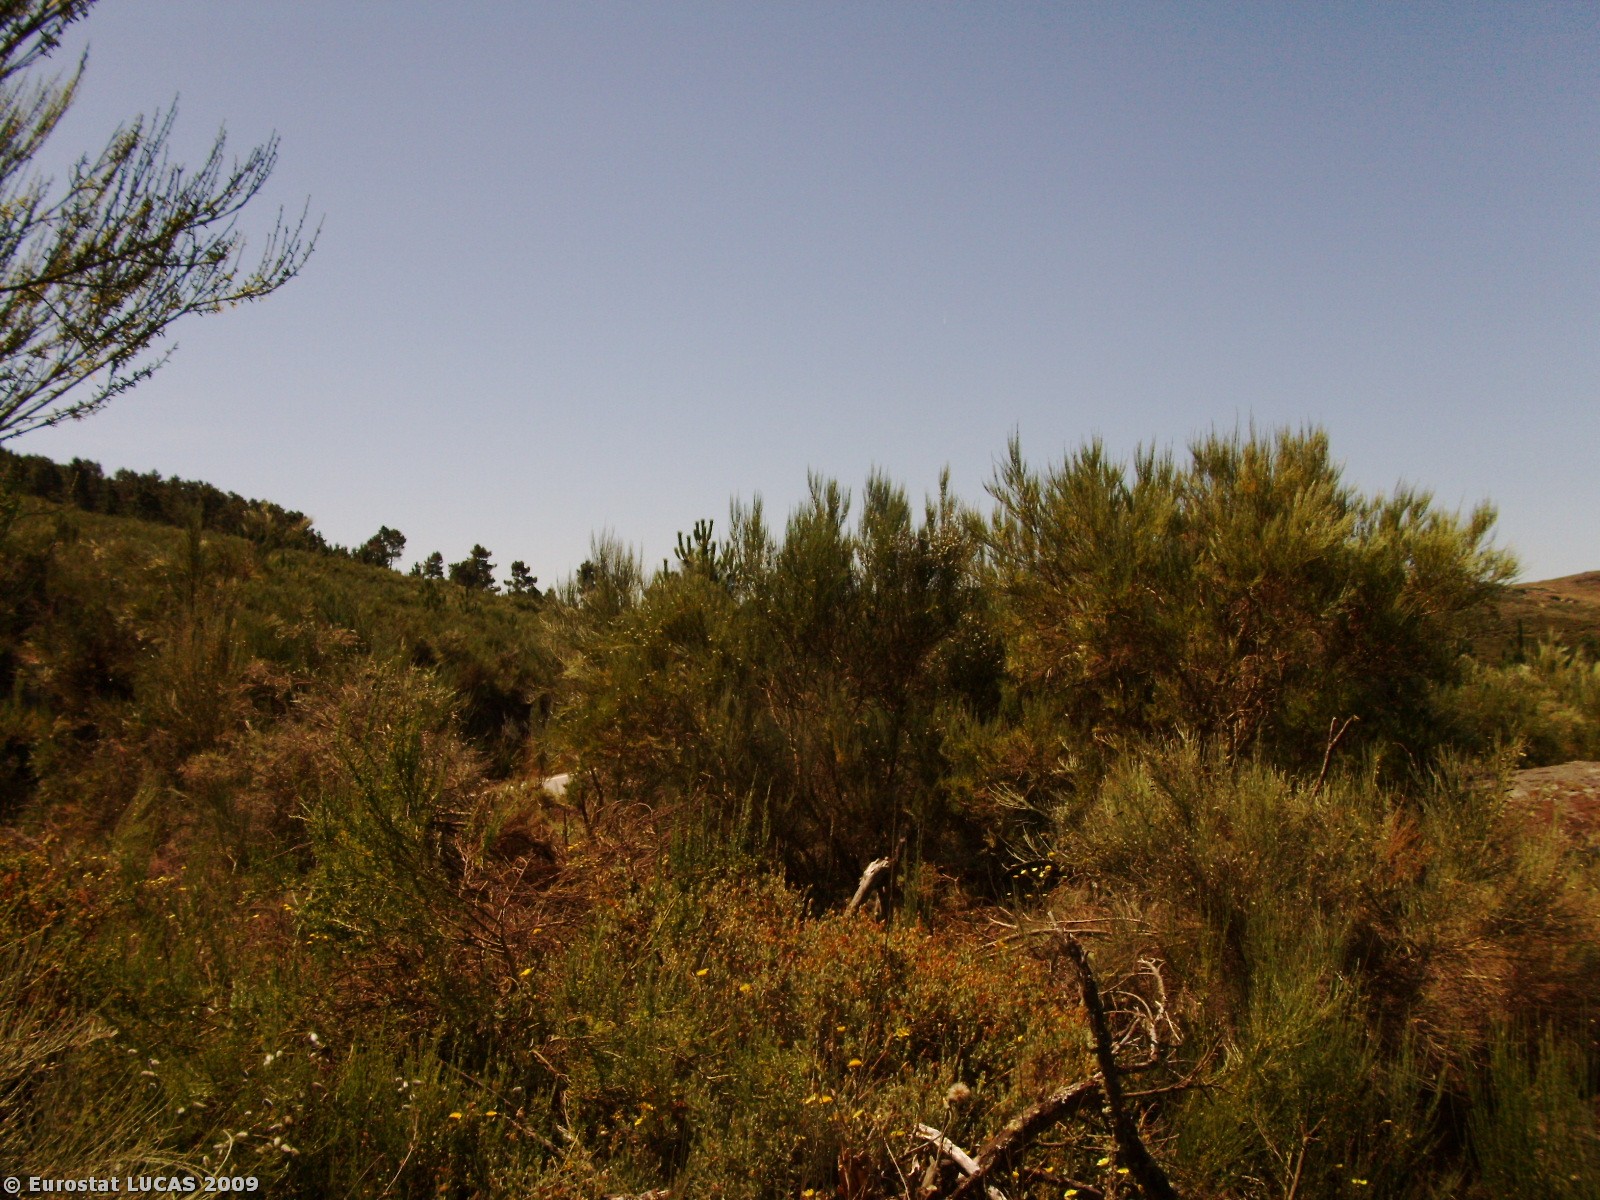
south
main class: Woodland
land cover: Coniferous woodland
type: coniferous forest of the mediterranean region
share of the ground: 25 - 50 %
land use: Forestry
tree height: > 5 m
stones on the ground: < 10 %
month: July
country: PT
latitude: 40.9790
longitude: -7.7505
